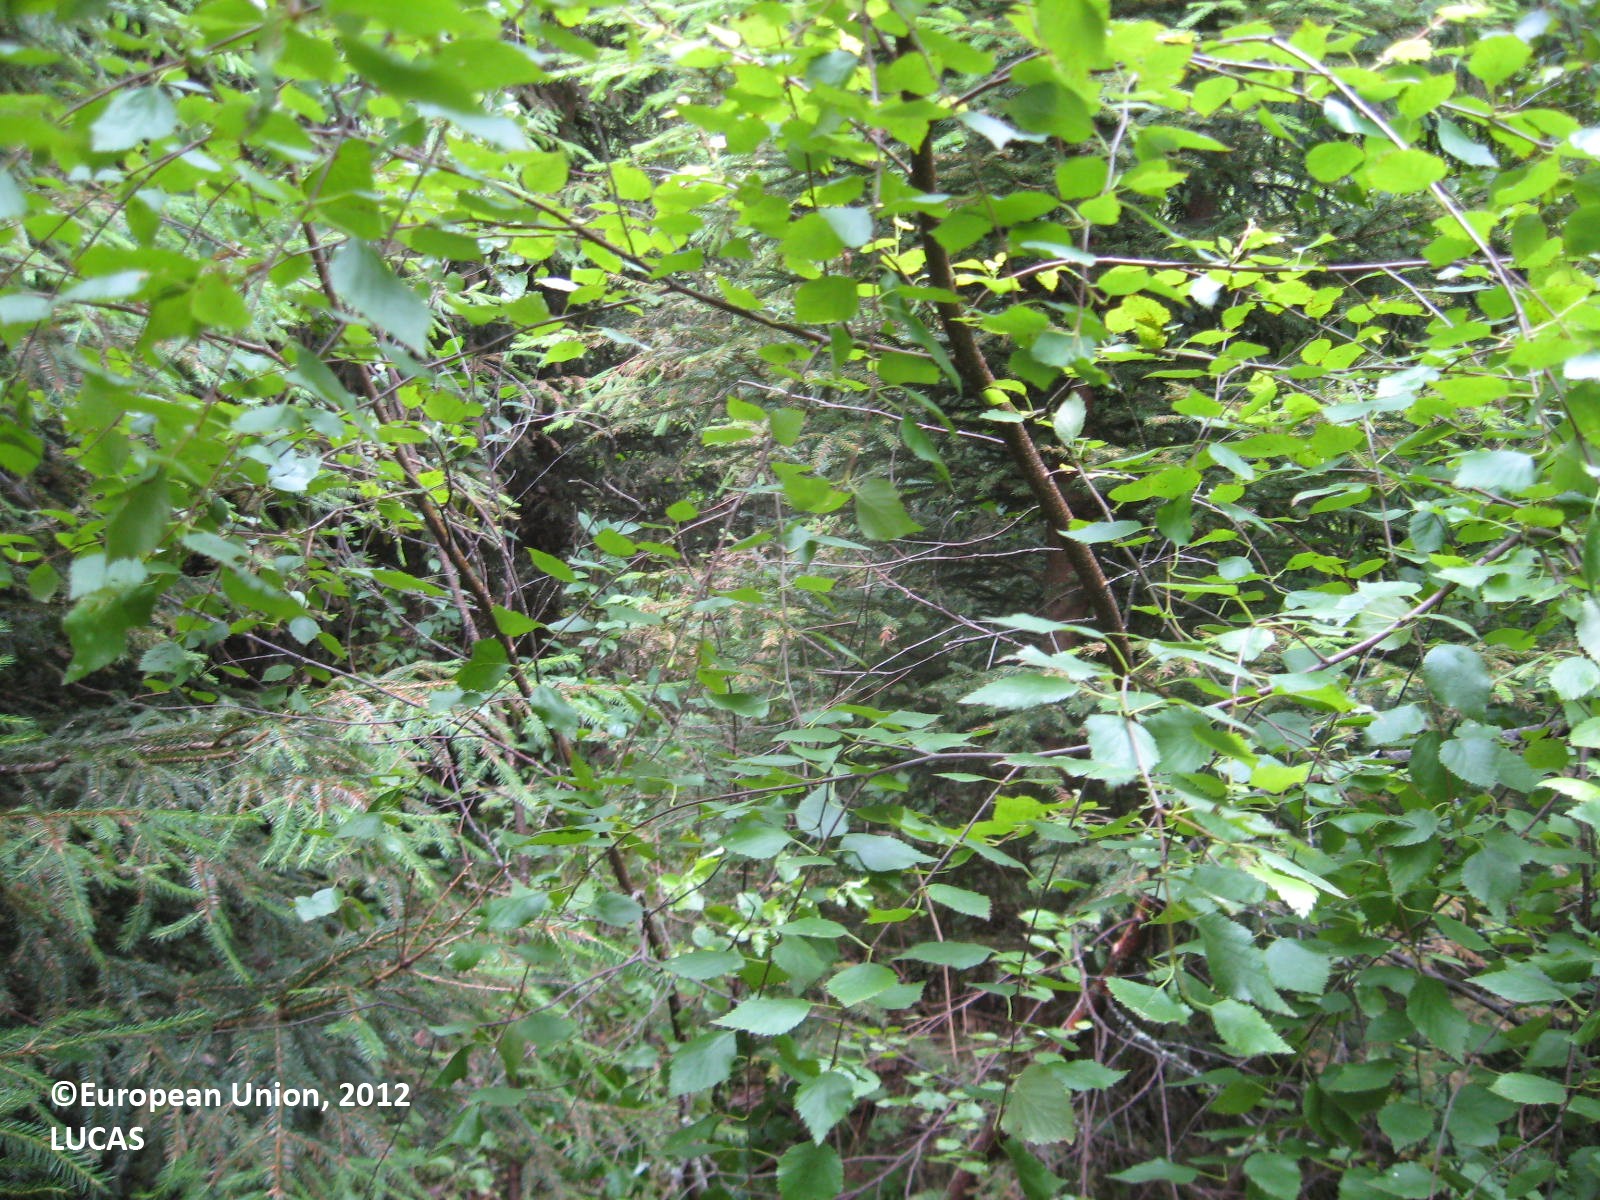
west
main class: Woodland
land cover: Other mixed woodland
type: boreal forest
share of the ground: > 75 %
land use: Forestry
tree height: > 5 m
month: July
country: FI
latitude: 61.8387
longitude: 21.5396
